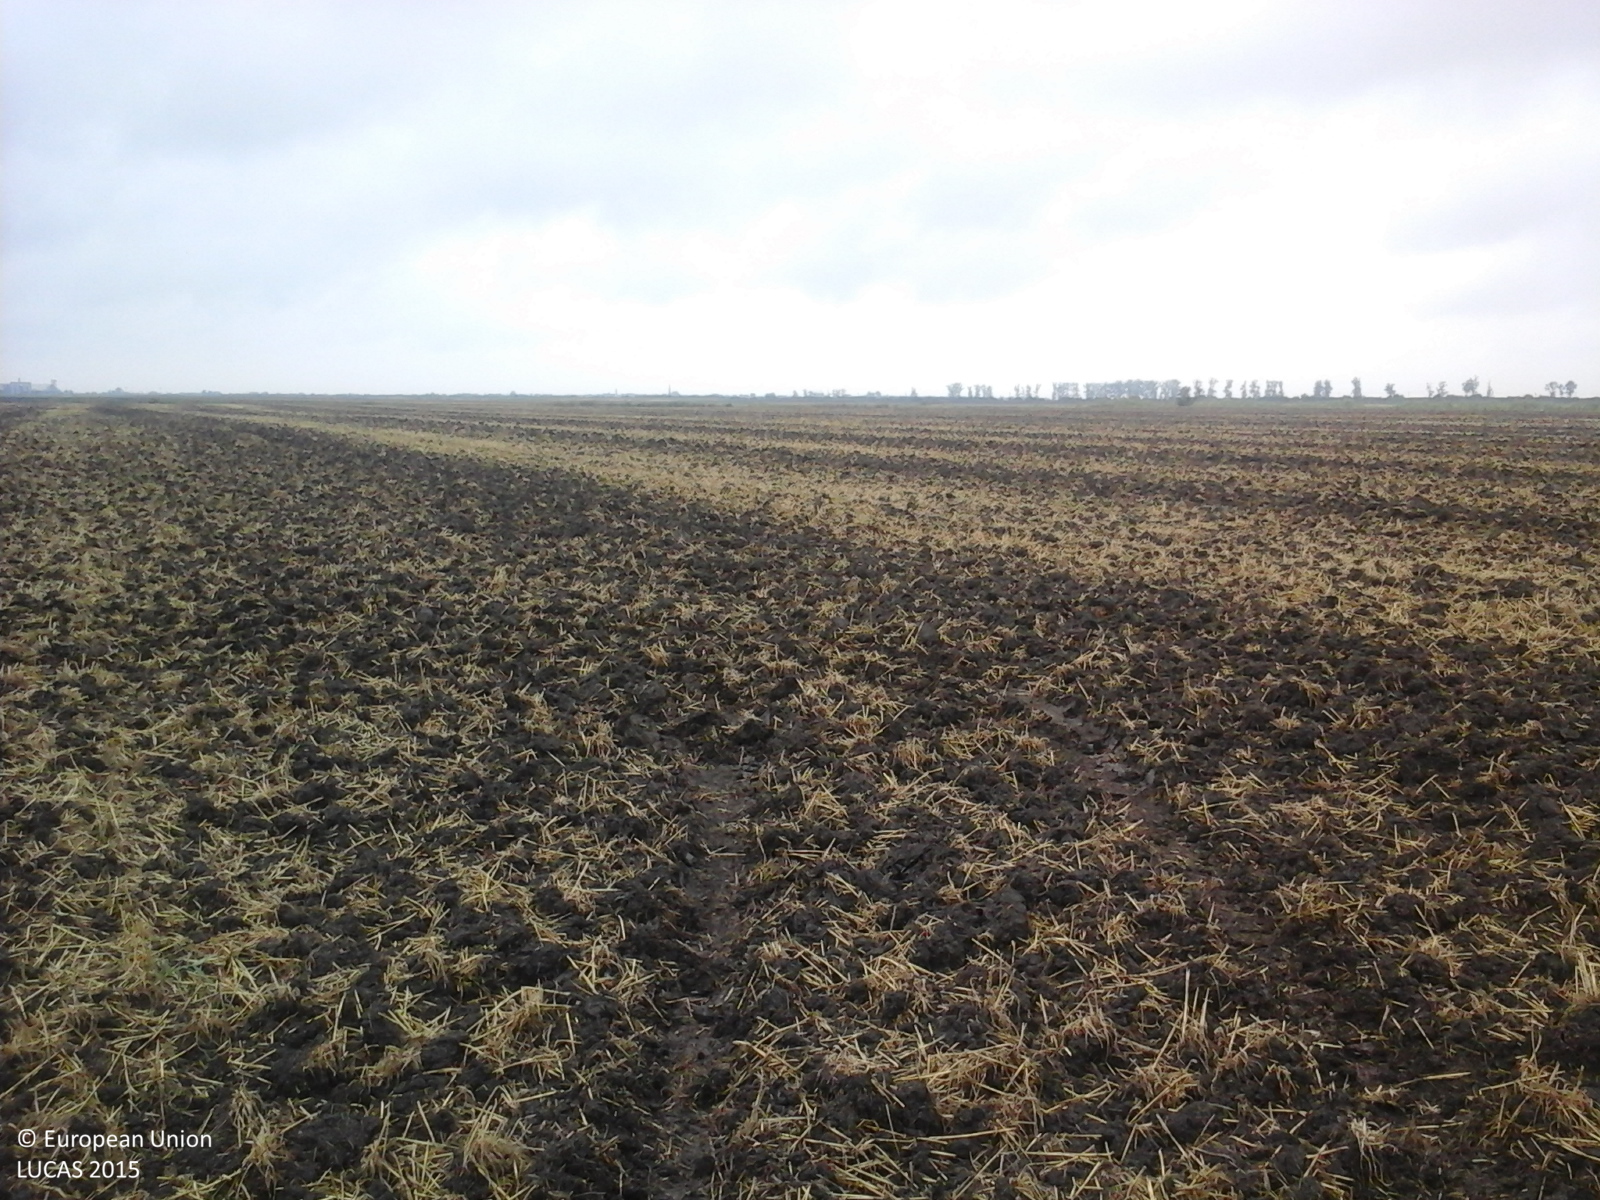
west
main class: Cropland
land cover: Common wheat
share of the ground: < 10 %
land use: Agriculture (excluding fallow land and kitchen gardens)
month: August
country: RO
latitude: 46.0019
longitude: 20.4443
